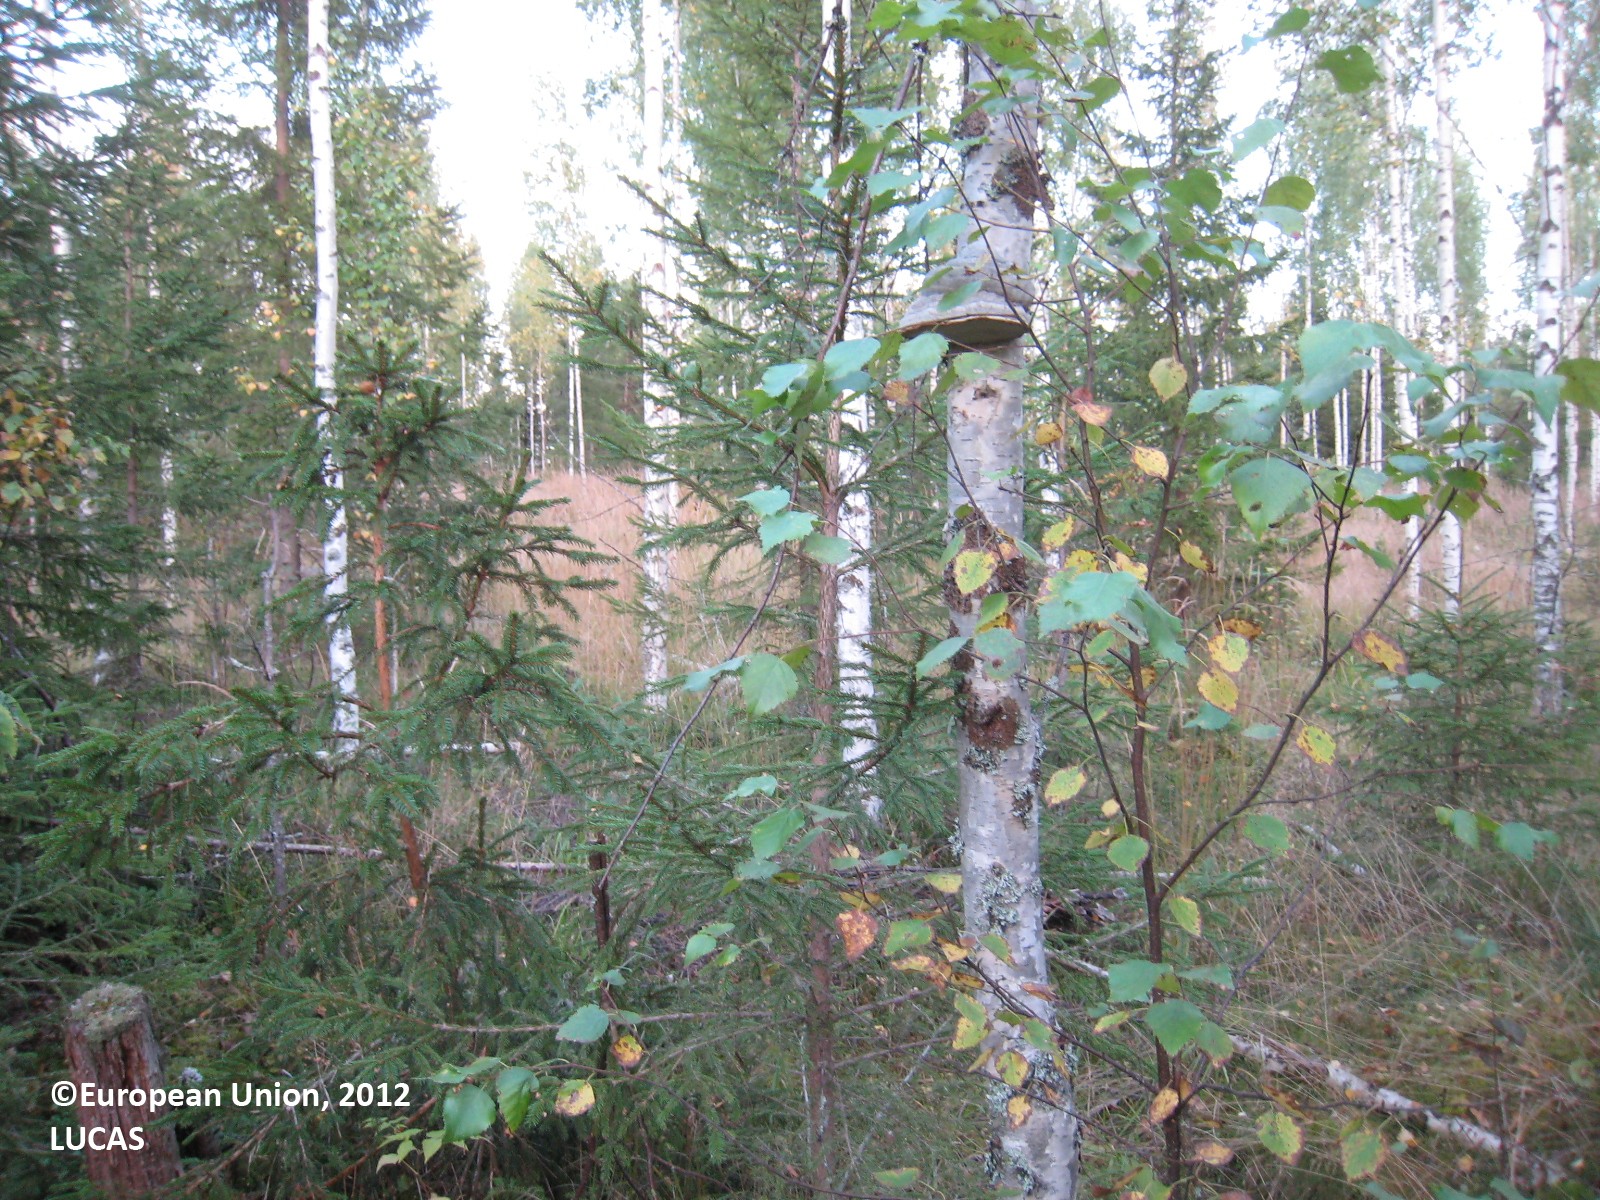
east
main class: Woodland
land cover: Spruce dominated mixed woodland
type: boreal forest
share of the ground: 50 - 75 %
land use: Forestry
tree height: > 5 m
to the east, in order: Spruce dominated mixed woodland; Other mixed woodland; Spruce dominated mixed woodland; Grassland without tree/shrub cover; Shrubland without tree cover; Grassland without tree/shrub cover
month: September
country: FI
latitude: 62.6403
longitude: 26.4600
